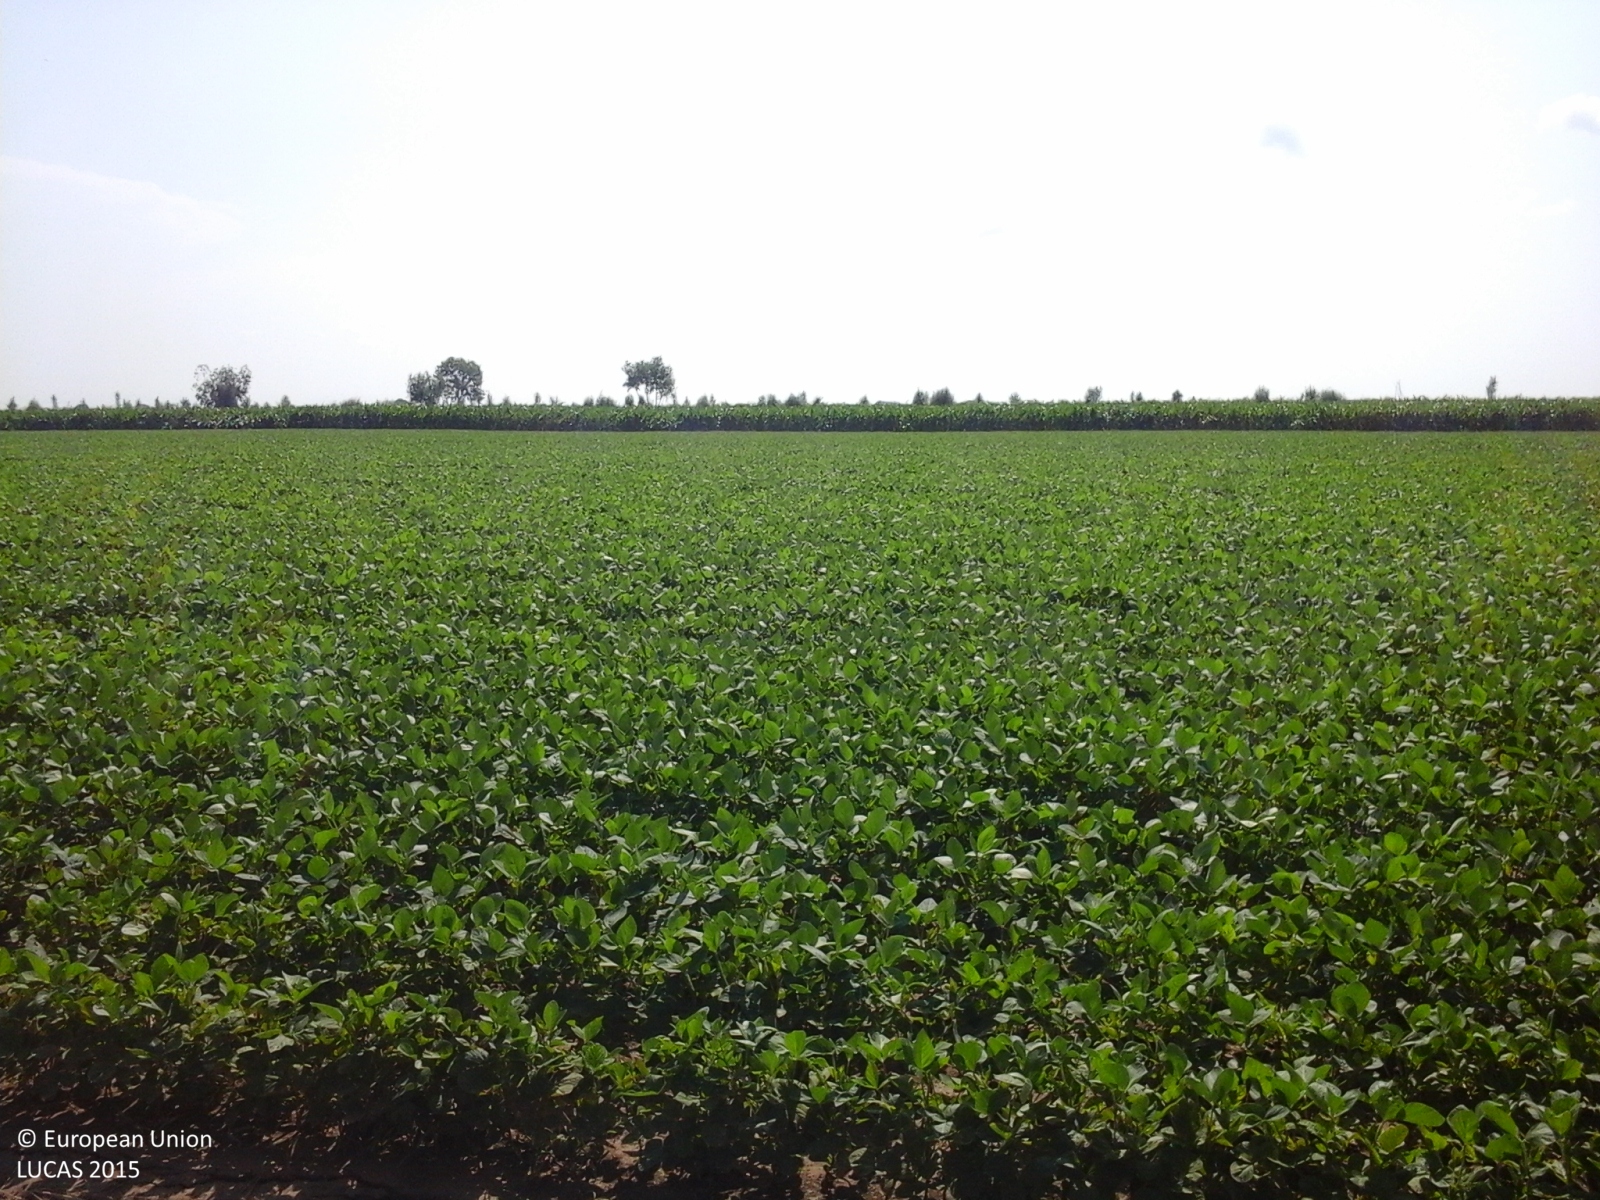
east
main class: Cropland
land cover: Soya
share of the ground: > 75 %
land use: Agriculture (excluding fallow land and kitchen gardens)
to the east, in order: Soya; Ditches and canals; Maize; Managed hedges; Ditches and canals; Managed hedges; Maize; Other fresh vegetables; Ditches and canals; Vineyards; Ditches and canals; Maize; Ditches and canals; Soya; Ditches and canals; Managed hedges; Grassland without tree/shrub cover
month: June
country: IT
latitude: 45.5781
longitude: 12.7002
